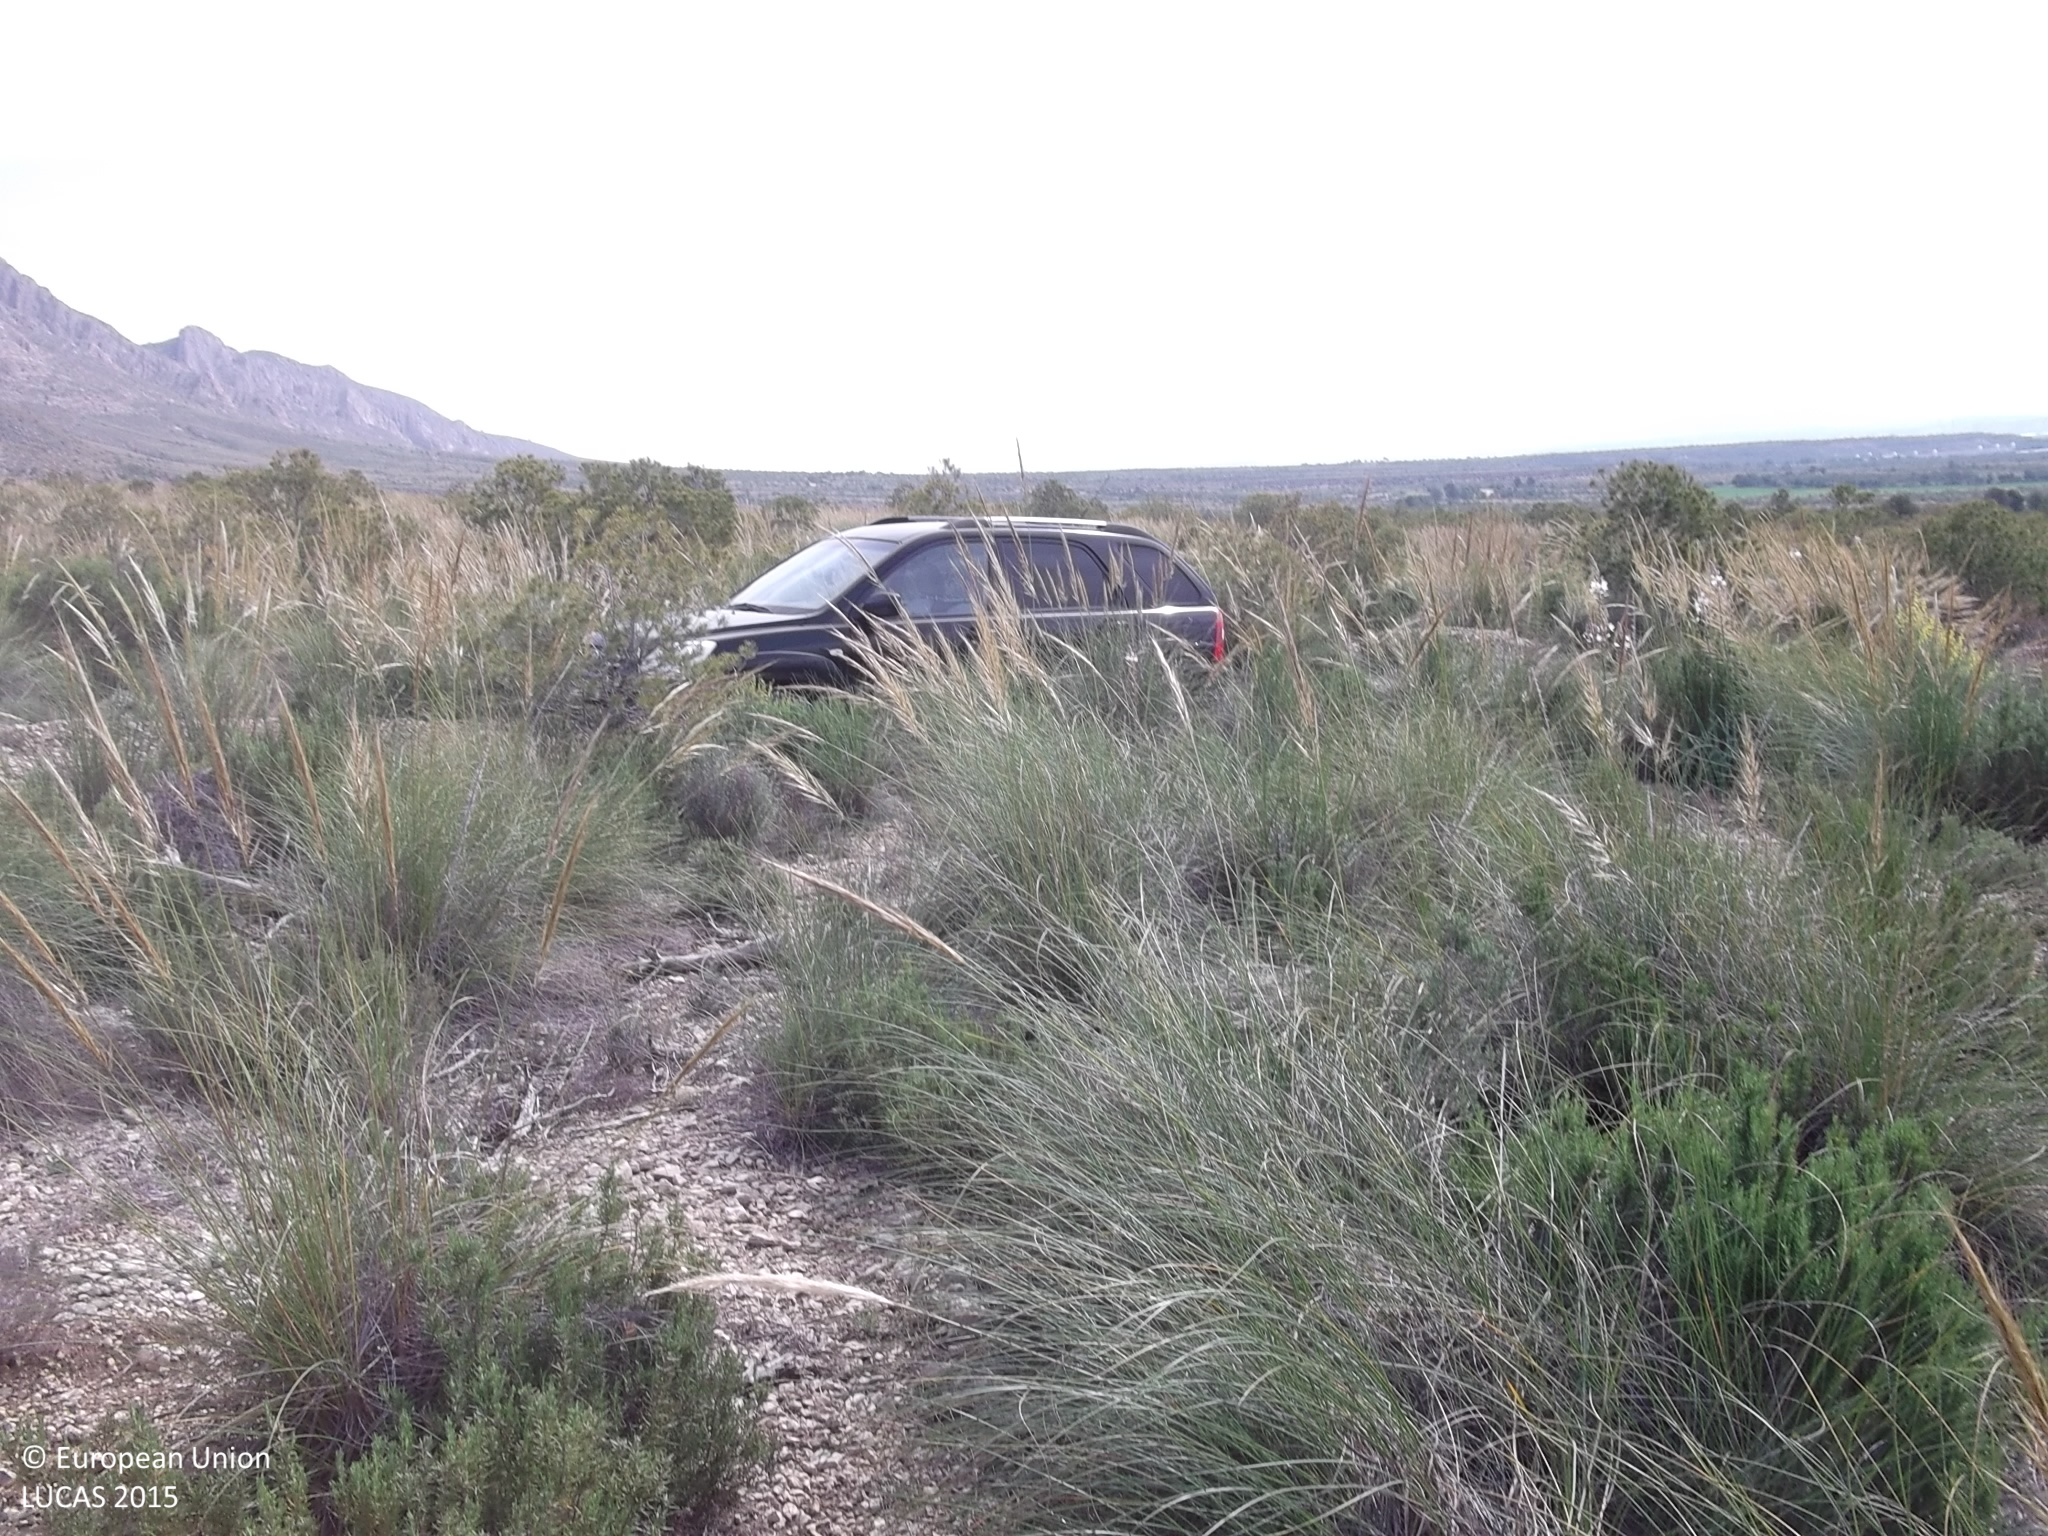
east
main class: Woodland
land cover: Pine dominated coniferous woodland
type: coniferous forest of the mediterranean region
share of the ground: 10 - 25 %
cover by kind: shrubs 65 %, consolidated bare surface 20 %, coniferous forest trees 15 %
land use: Semi-natural and natural areas not in use
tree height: < 5 m
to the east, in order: Pine dominated coniferous woodland; Tracks; Pine dominated coniferous woodland; Tracks; Pine dominated coniferous woodland
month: April
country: ES
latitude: 38.2953
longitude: -1.6186
